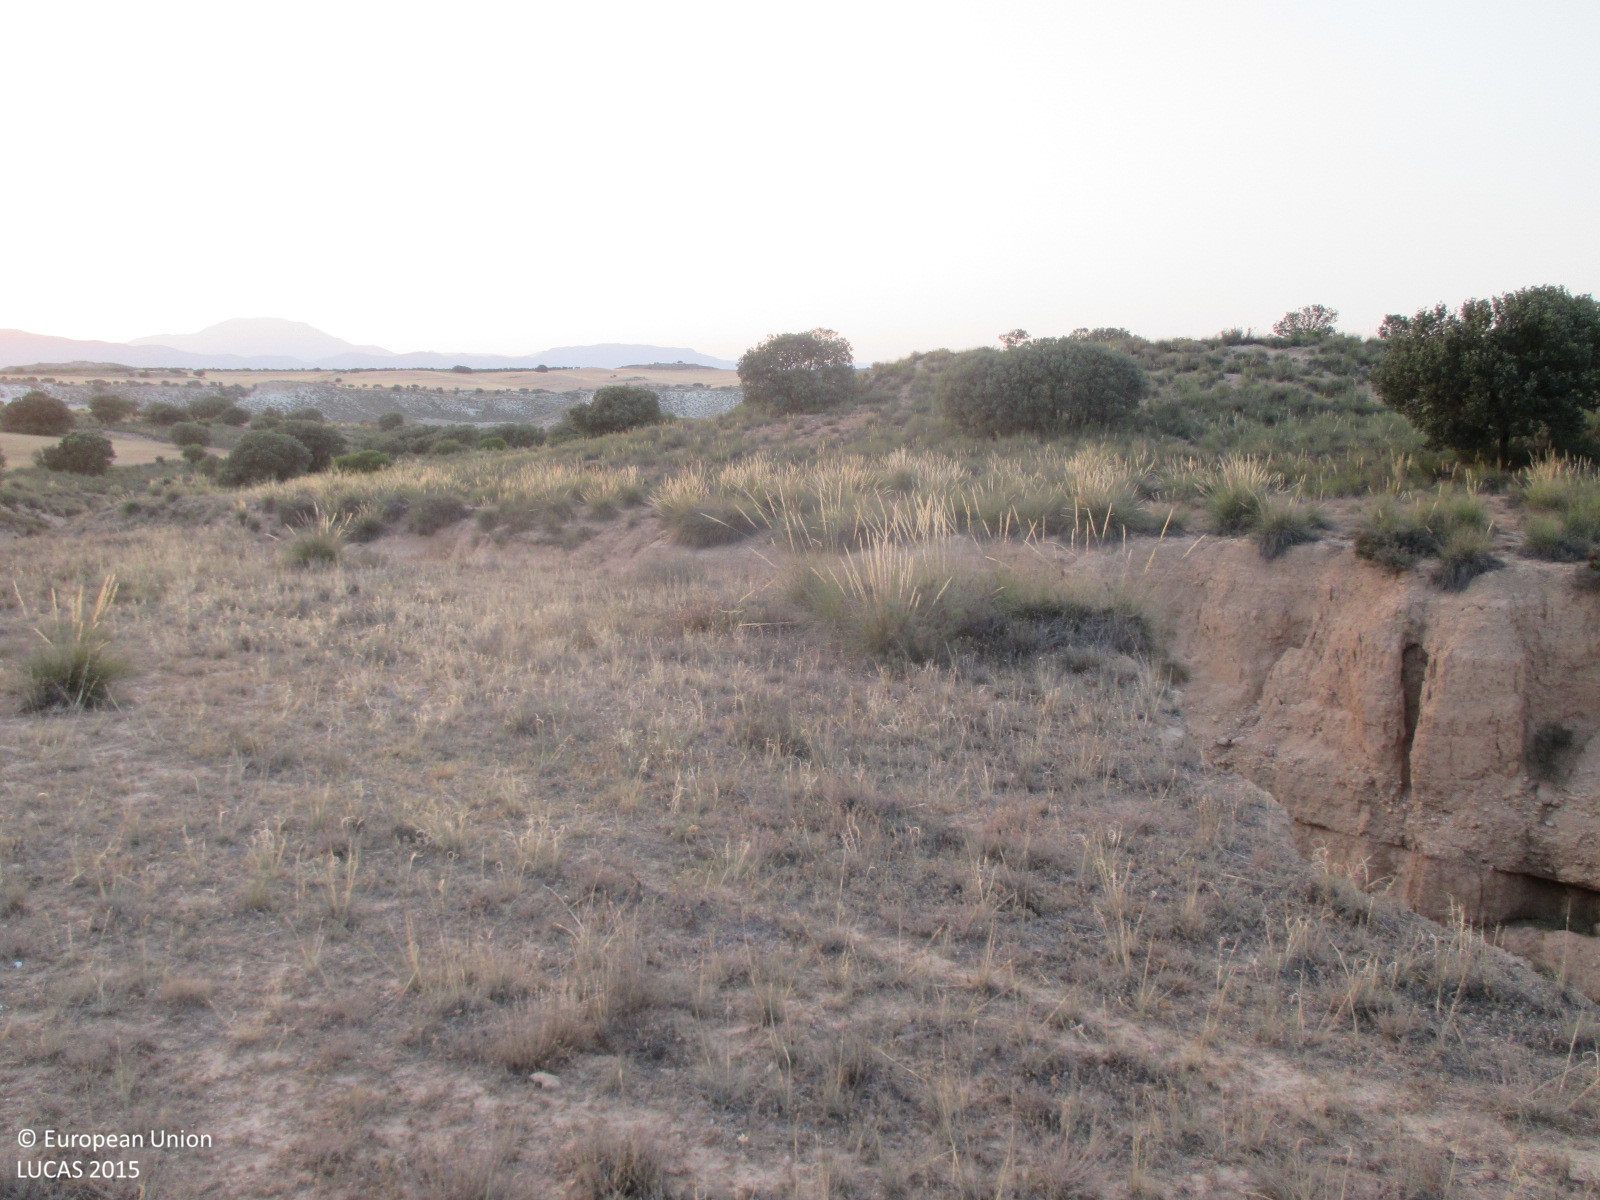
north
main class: Grassland
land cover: Grassland without tree/shrub cover
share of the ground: > 75 %
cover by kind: herbaceous plants 100 %
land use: Semi-natural and natural areas not in use
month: June
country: ES
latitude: 37.7637
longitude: -2.3498
